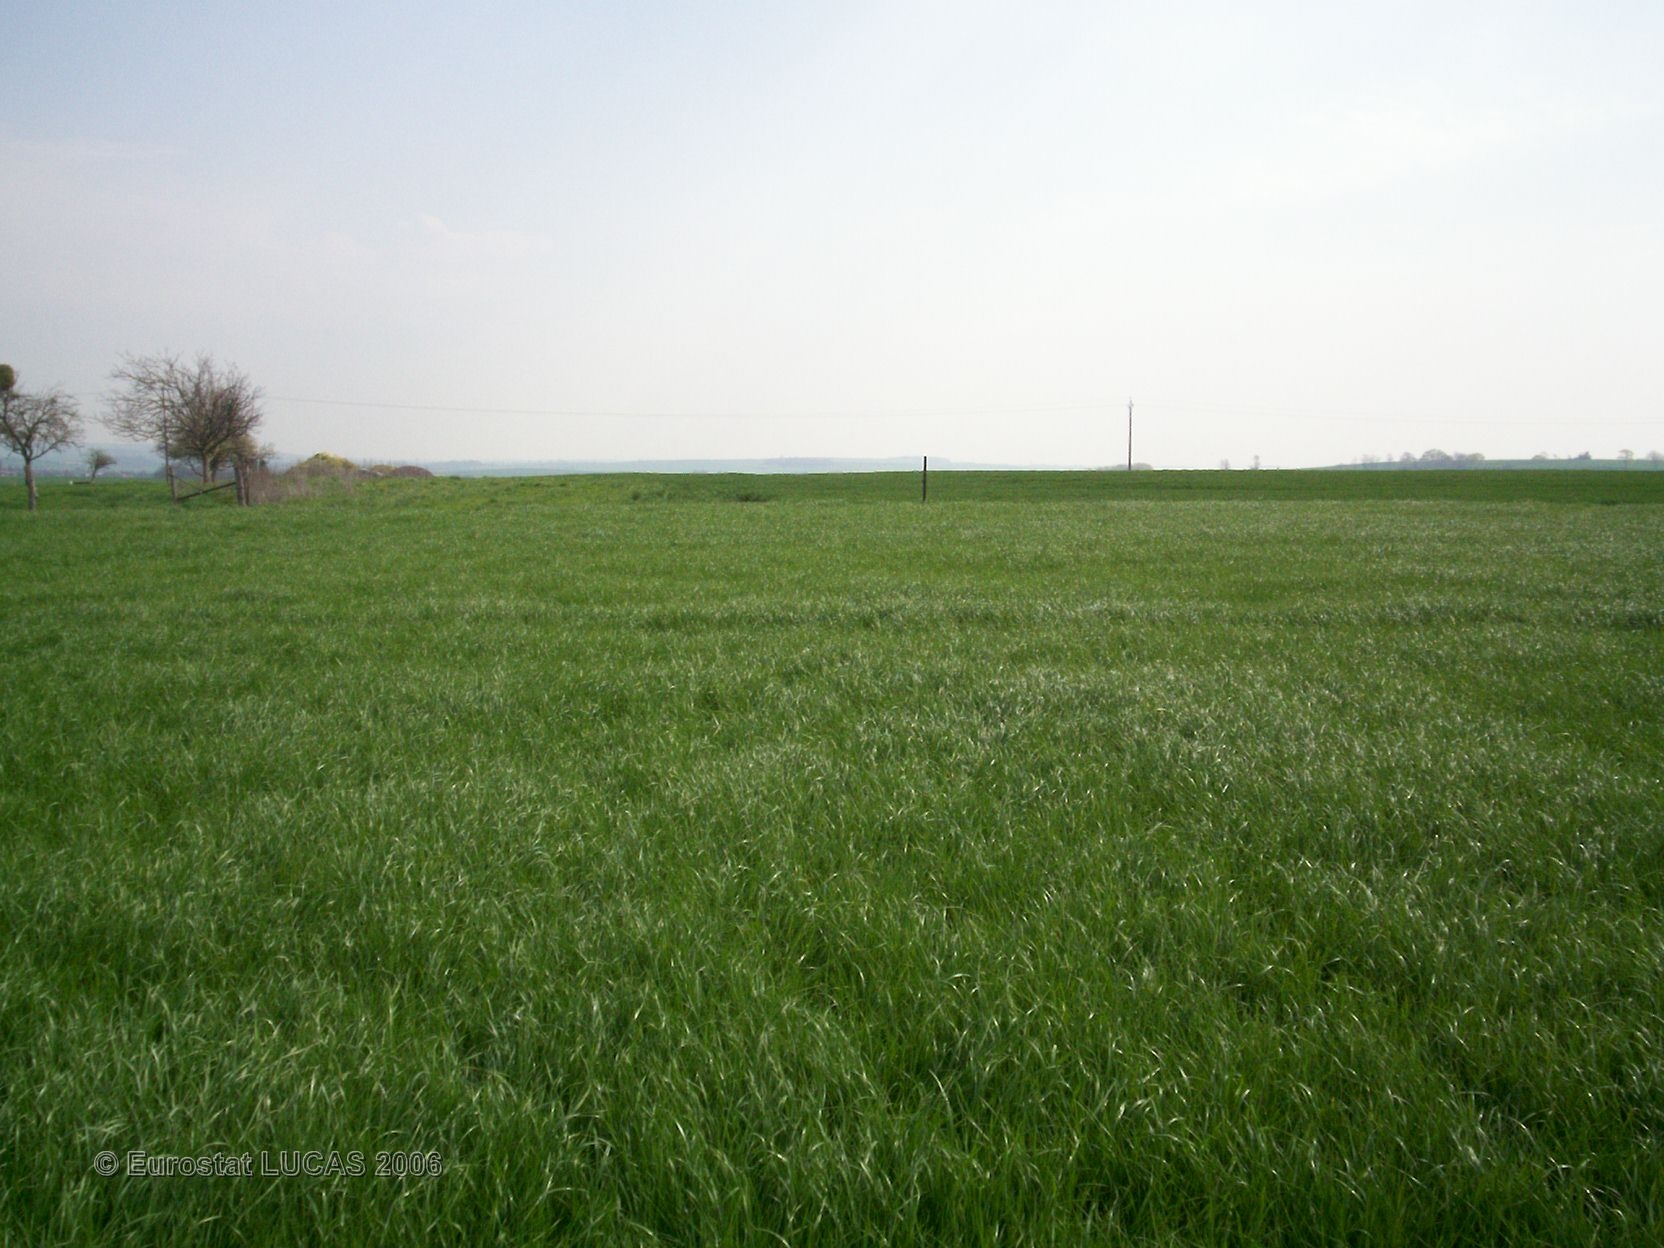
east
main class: Grassland
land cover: Grassland without tree/shrub cover
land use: Agriculture (excluding fallow land and kitchen gardens)
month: April
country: FR
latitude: 48.7633
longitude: 6.5312
